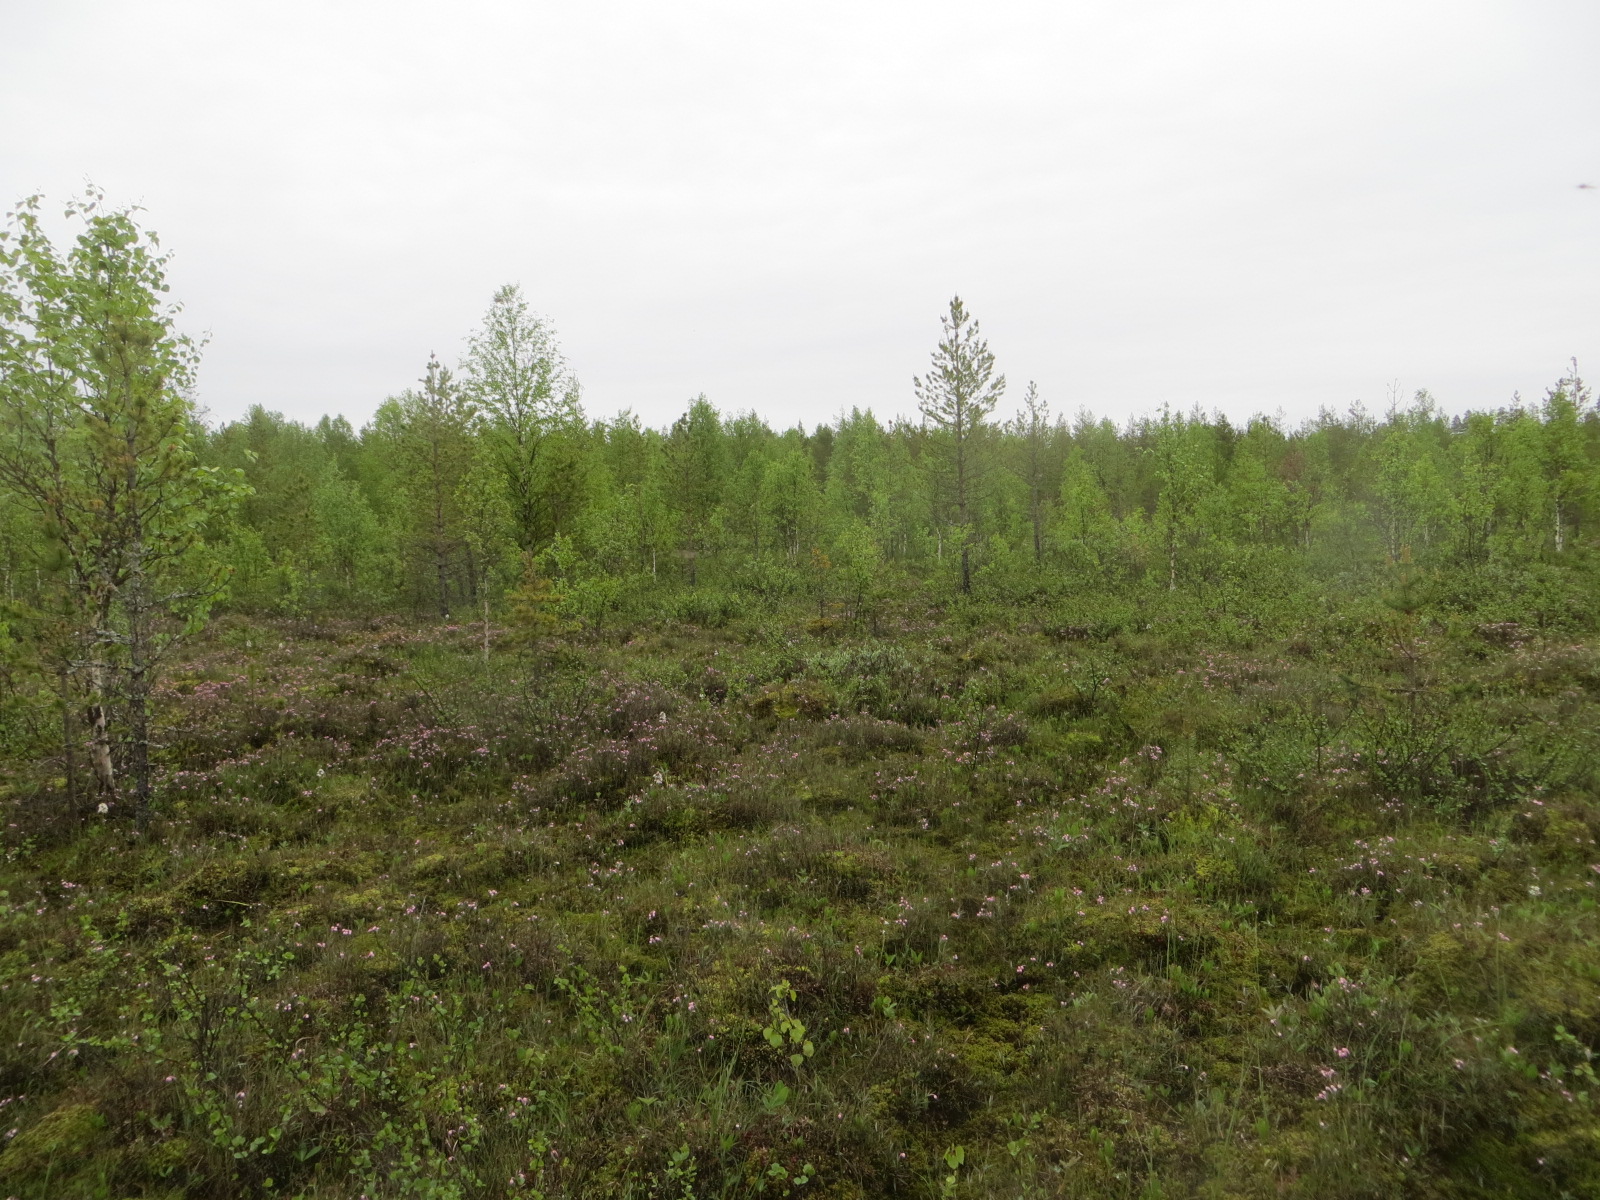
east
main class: Woodland
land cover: Broadleaved woodland
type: mire and swamp forests
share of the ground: 50 - 75 %
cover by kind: broadleaved forest trees 50 %, shrubs 40 %, coniferous forest trees 10 %
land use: Forestry
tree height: > 5 m
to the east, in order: Broadleaved woodland; Pine dominated mixed woodland; Ditches and canals; Pine dominated mixed woodland; Ditches and canals; Spruce dominated mixed woodland; Ditches and canals; Other mixed woodland
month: June
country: FI
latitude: 66.6358
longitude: 24.8041
